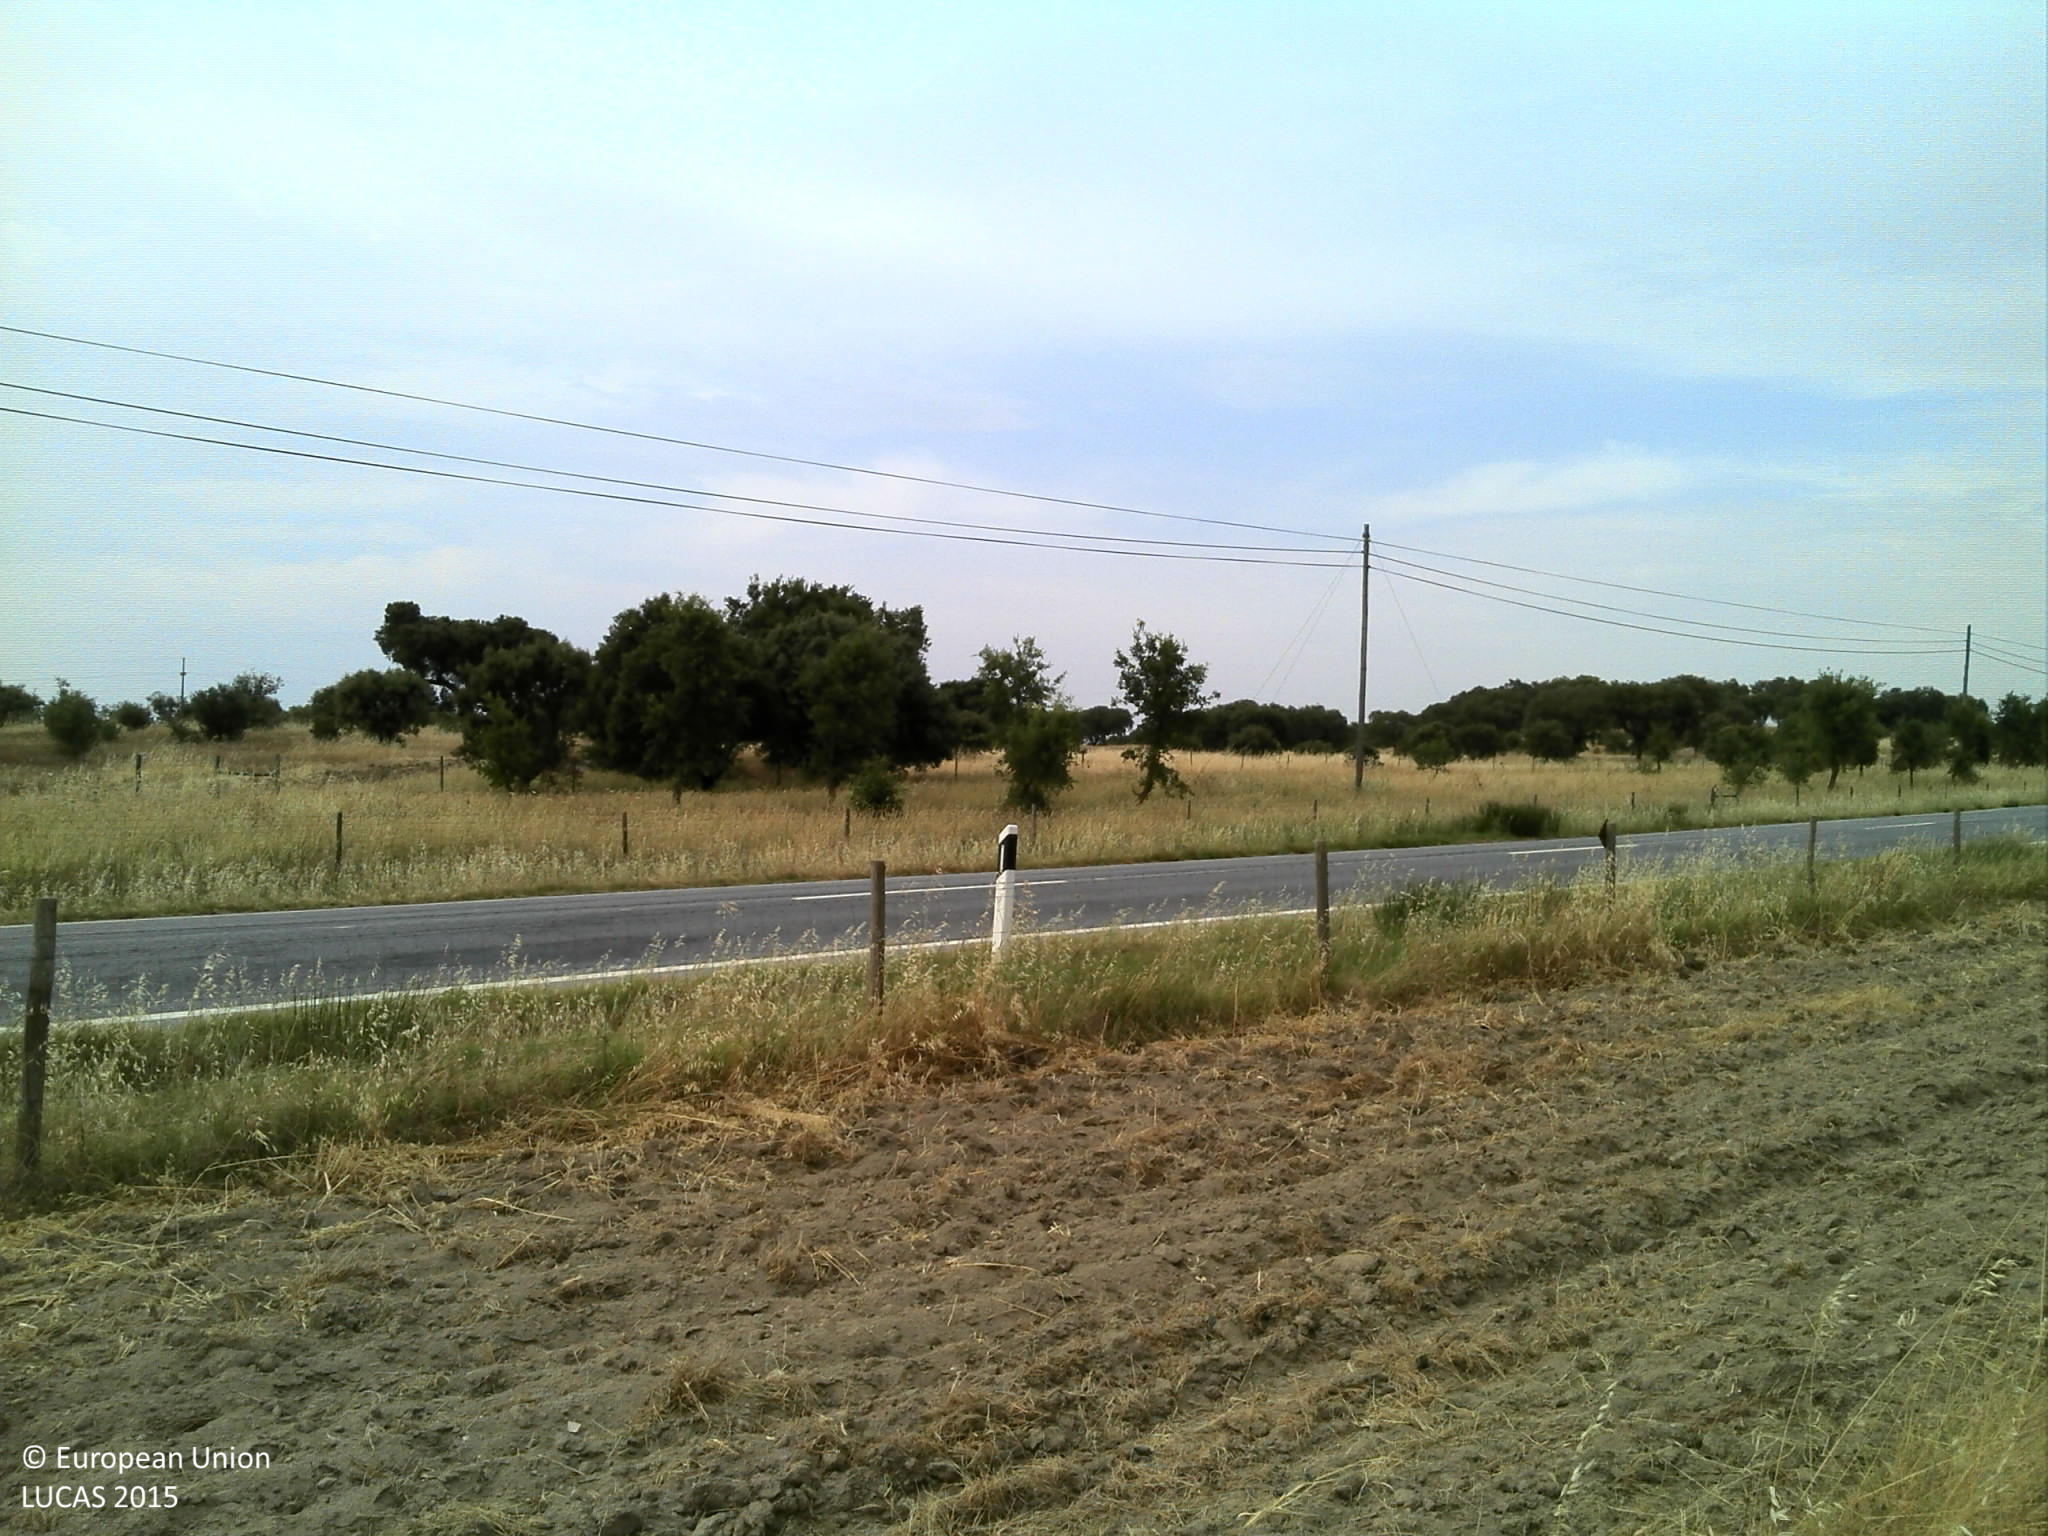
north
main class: Woodland
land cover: Broadleaved woodland
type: broadleaved evergreen forest
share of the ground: 25 - 50 %
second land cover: Grassland without tree/shrub cover
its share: 50 - 75 %
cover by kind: herbaceous plants 60 %, broadleaved forest trees 30 %, unconsolidated bare surface 10 %
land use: Forestry
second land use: Agriculture (excluding fallow land and kitchen gardens)
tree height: < 5 m
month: June
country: PT
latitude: 38.6318
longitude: -7.7622
